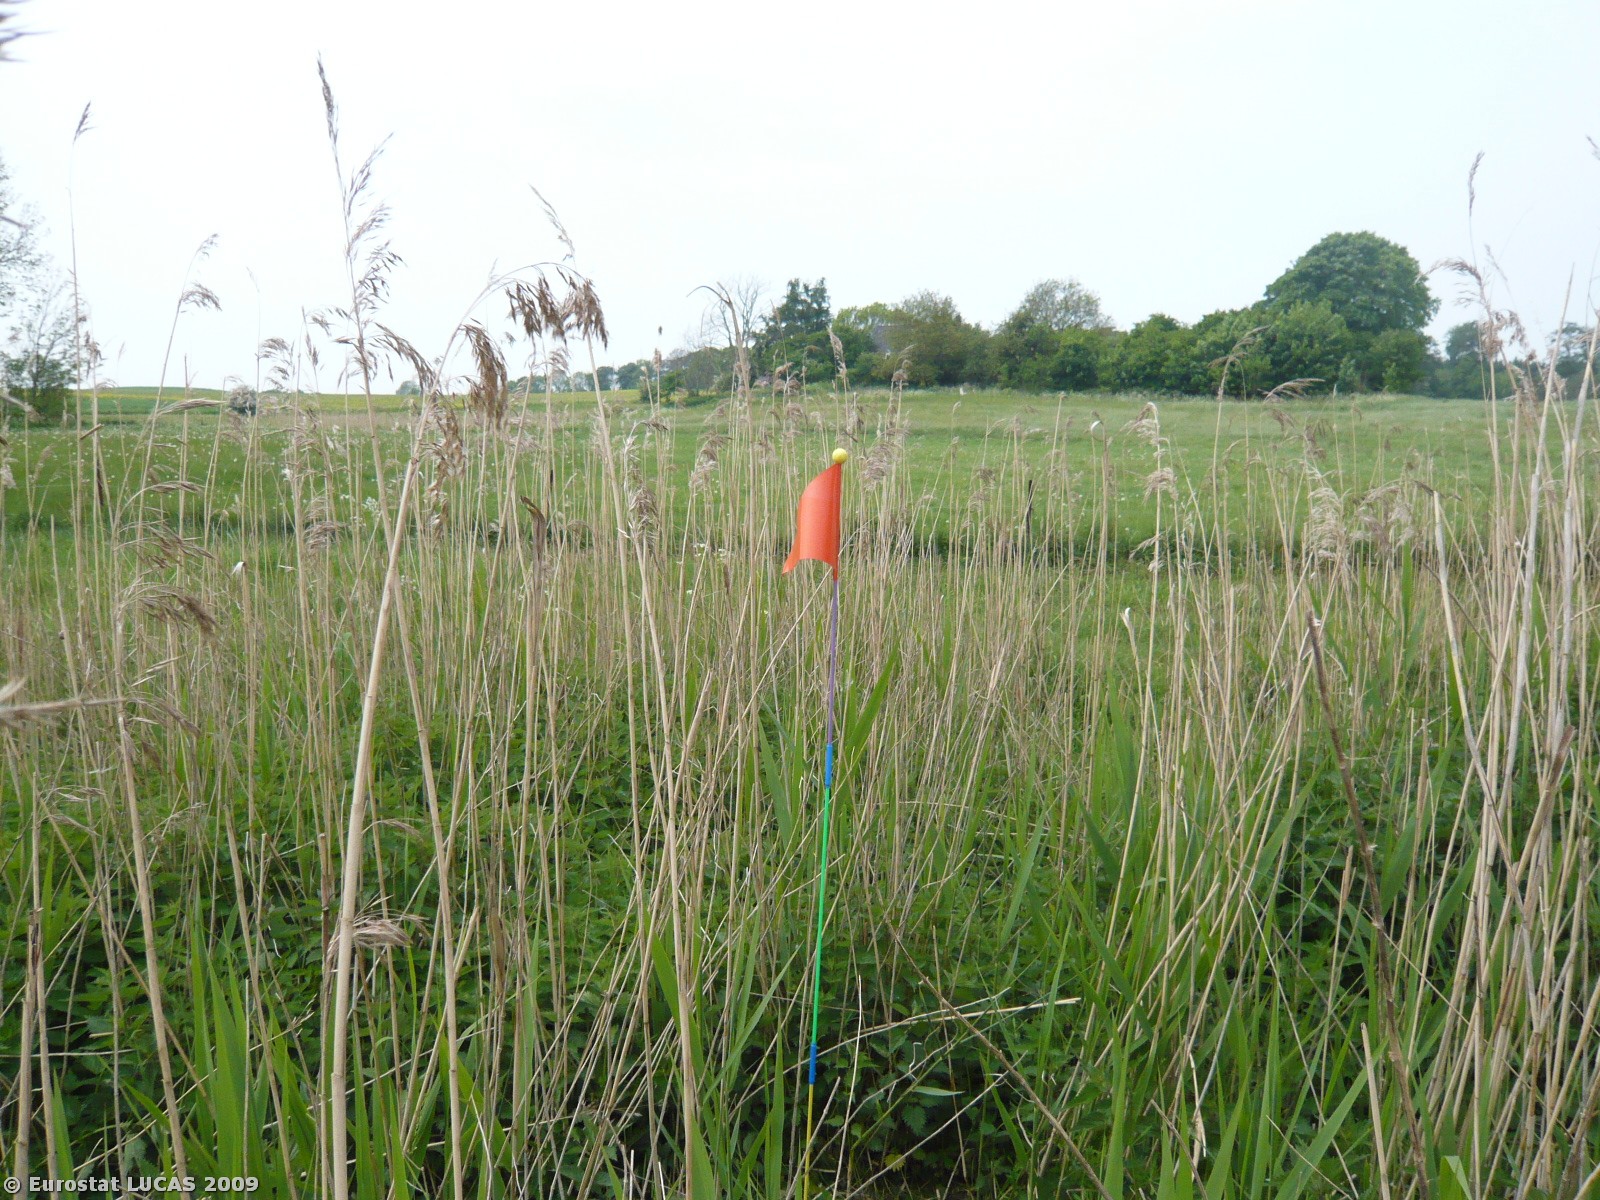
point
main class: Wetlands
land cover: Inland marshes
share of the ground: > 75 %
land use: Unused
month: May
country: DK
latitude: 55.2217
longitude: 11.8378
